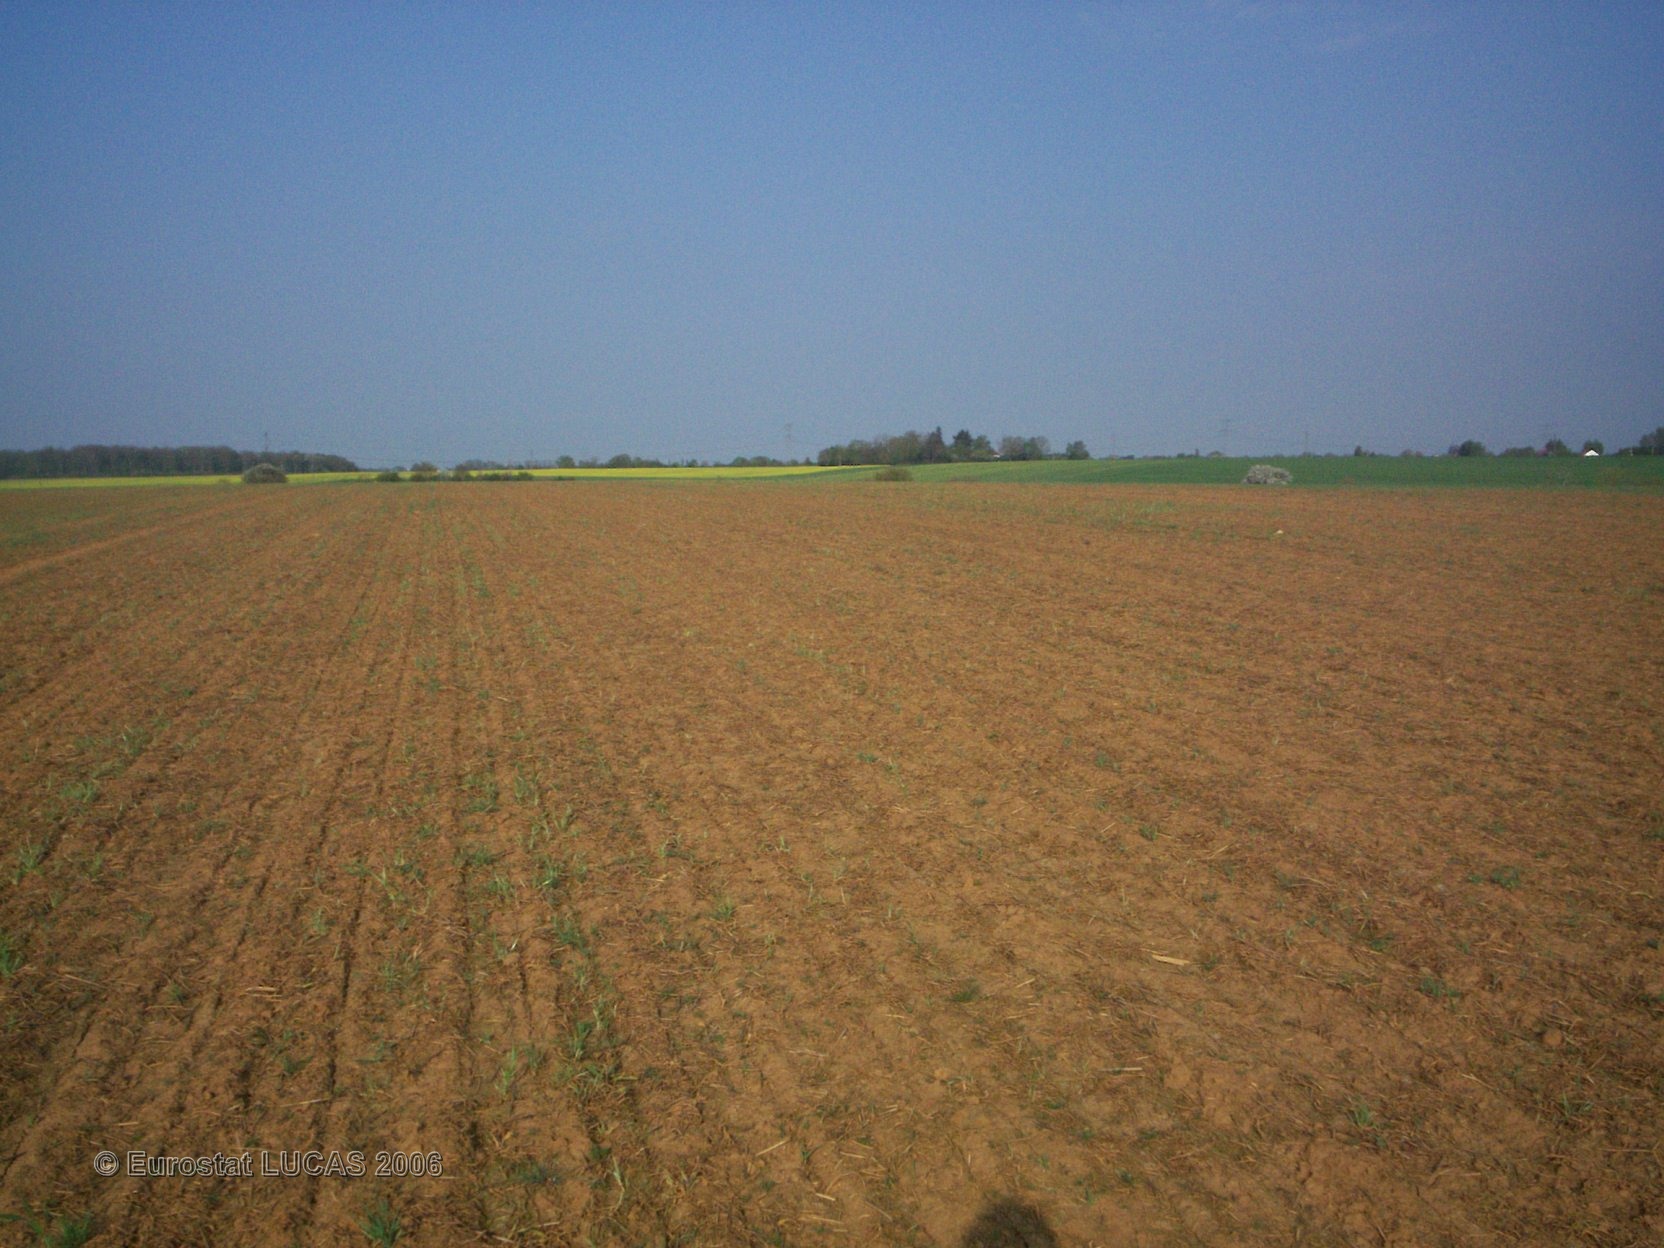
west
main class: Cropland
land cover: Barley
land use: Agriculture (excluding fallow land and kitchen gardens)
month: April
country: FR
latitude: 47.1923
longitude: 3.0662
